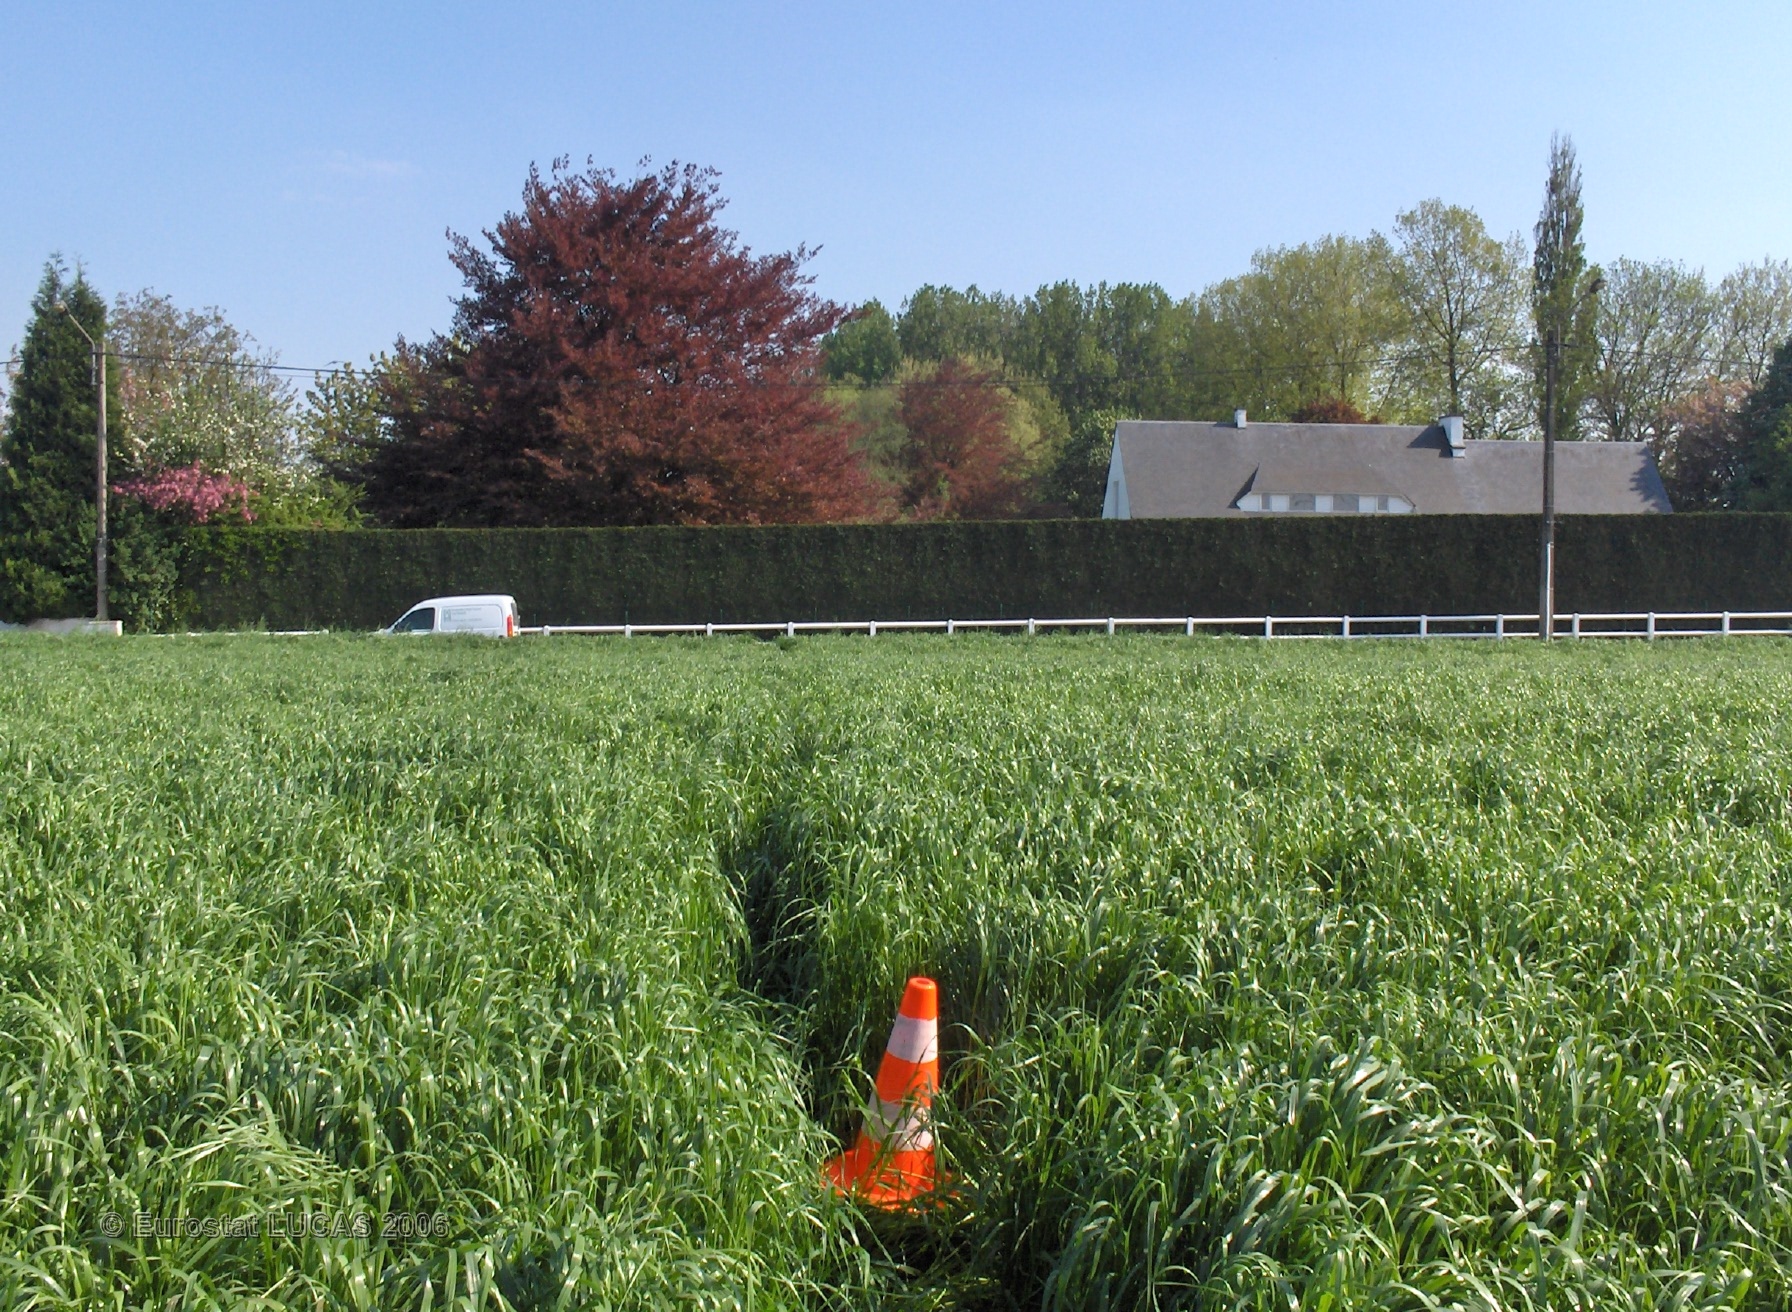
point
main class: Grassland
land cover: Grassland without tree/shrub cover
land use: Agriculture (excluding fallow land and kitchen gardens)
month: May
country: BE
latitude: 50.4655
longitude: 4.4874
